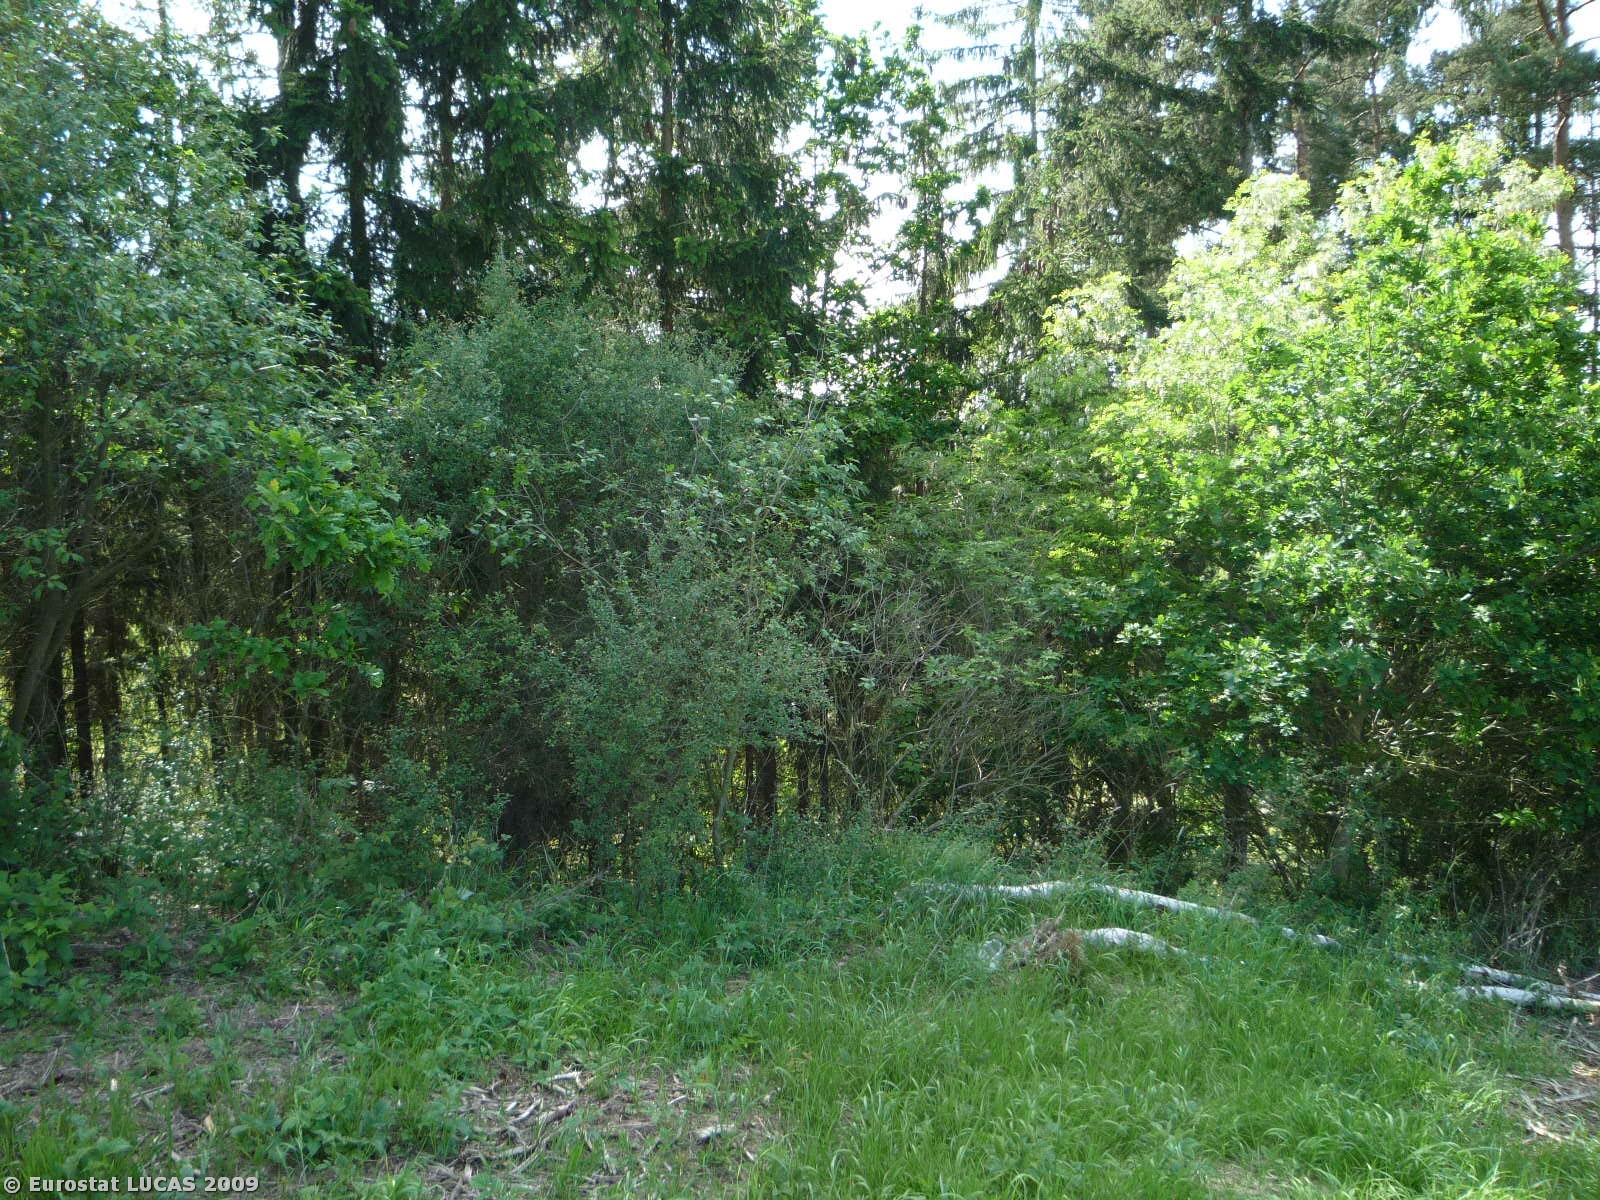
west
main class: Grassland
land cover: Spontaneously vegetated surfaces
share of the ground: > 75 %
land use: Fallow land
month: May
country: CZ
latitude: 49.7318
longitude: 15.0111
